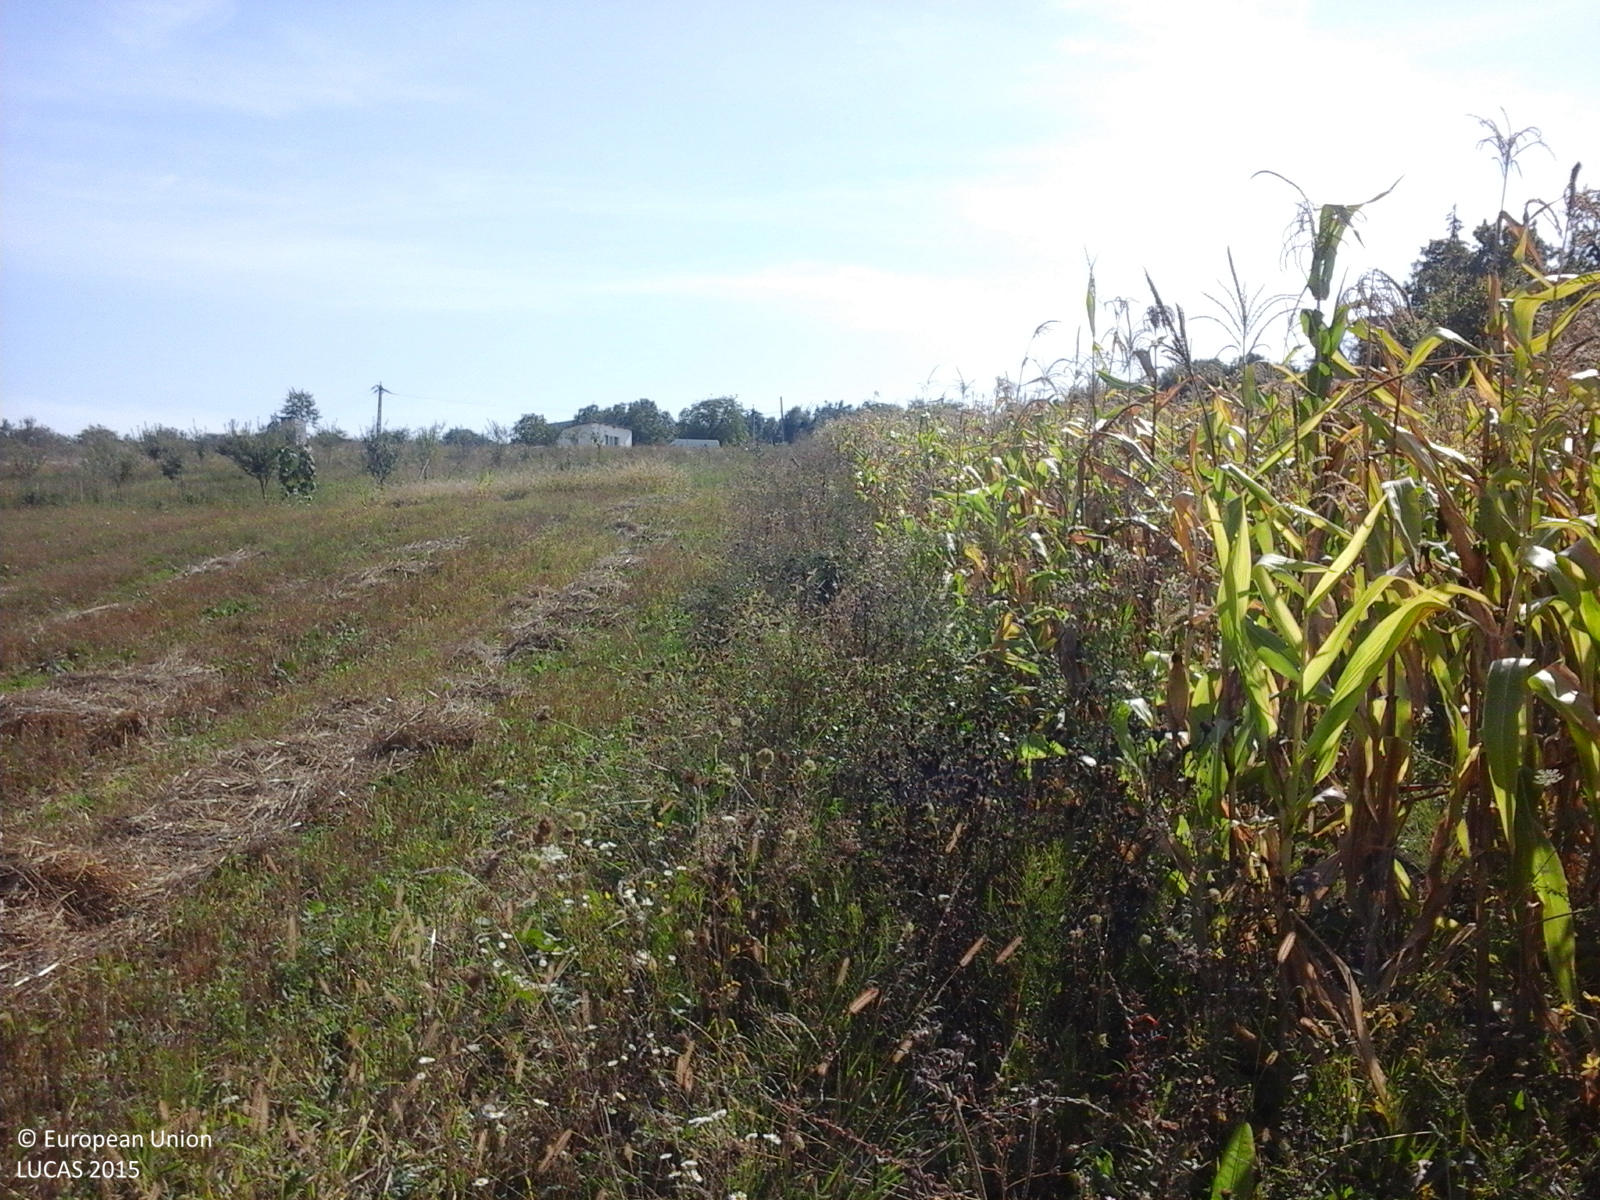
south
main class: Cropland
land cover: Maize
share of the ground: > 75 %
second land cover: Spontaneously vegetated surfaces
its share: 25 - 50 %
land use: Agriculture (excluding fallow land and kitchen gardens)
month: September
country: RO
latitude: 46.8653
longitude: 23.5967
